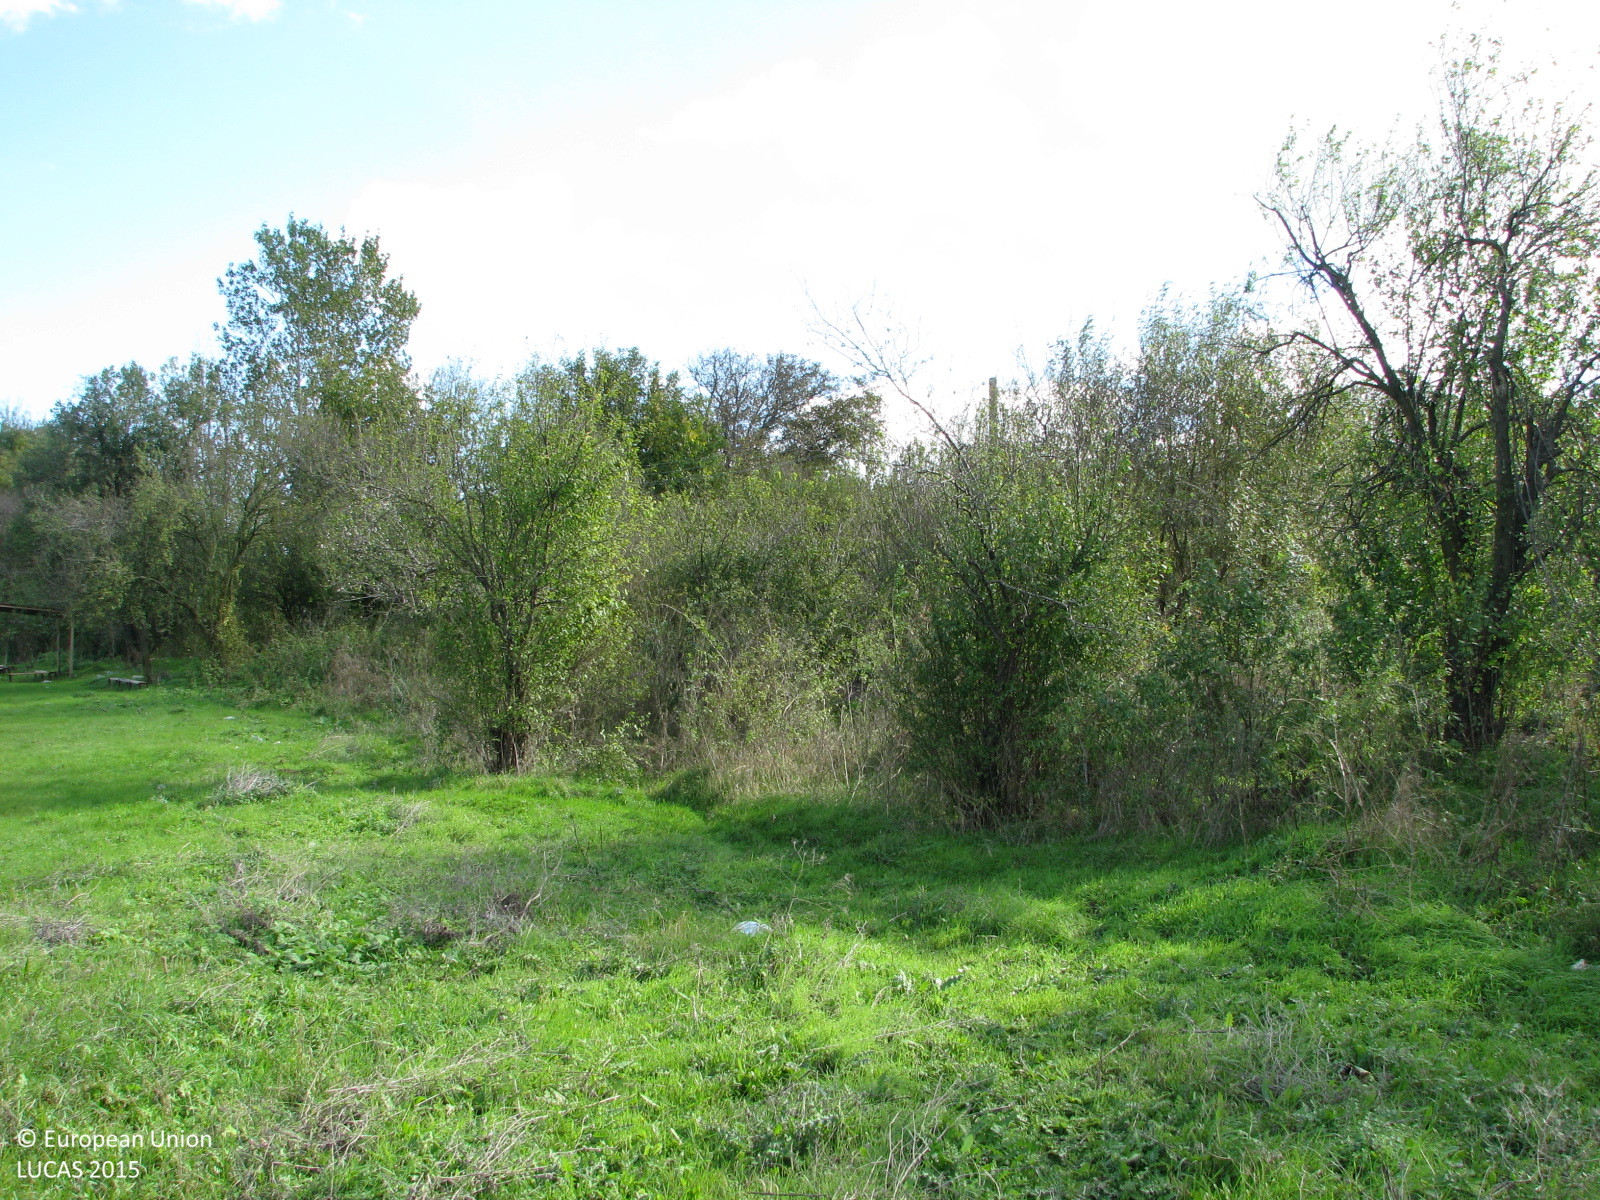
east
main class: Grassland
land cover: Grassland without tree/shrub cover
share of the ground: > 75 %
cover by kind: herbaceous plants 100 %
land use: Sport
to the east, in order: Grassland without tree/shrub cover; Artificial constructions in urban areas
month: October
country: BG
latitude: 42.3358
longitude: 26.7354
